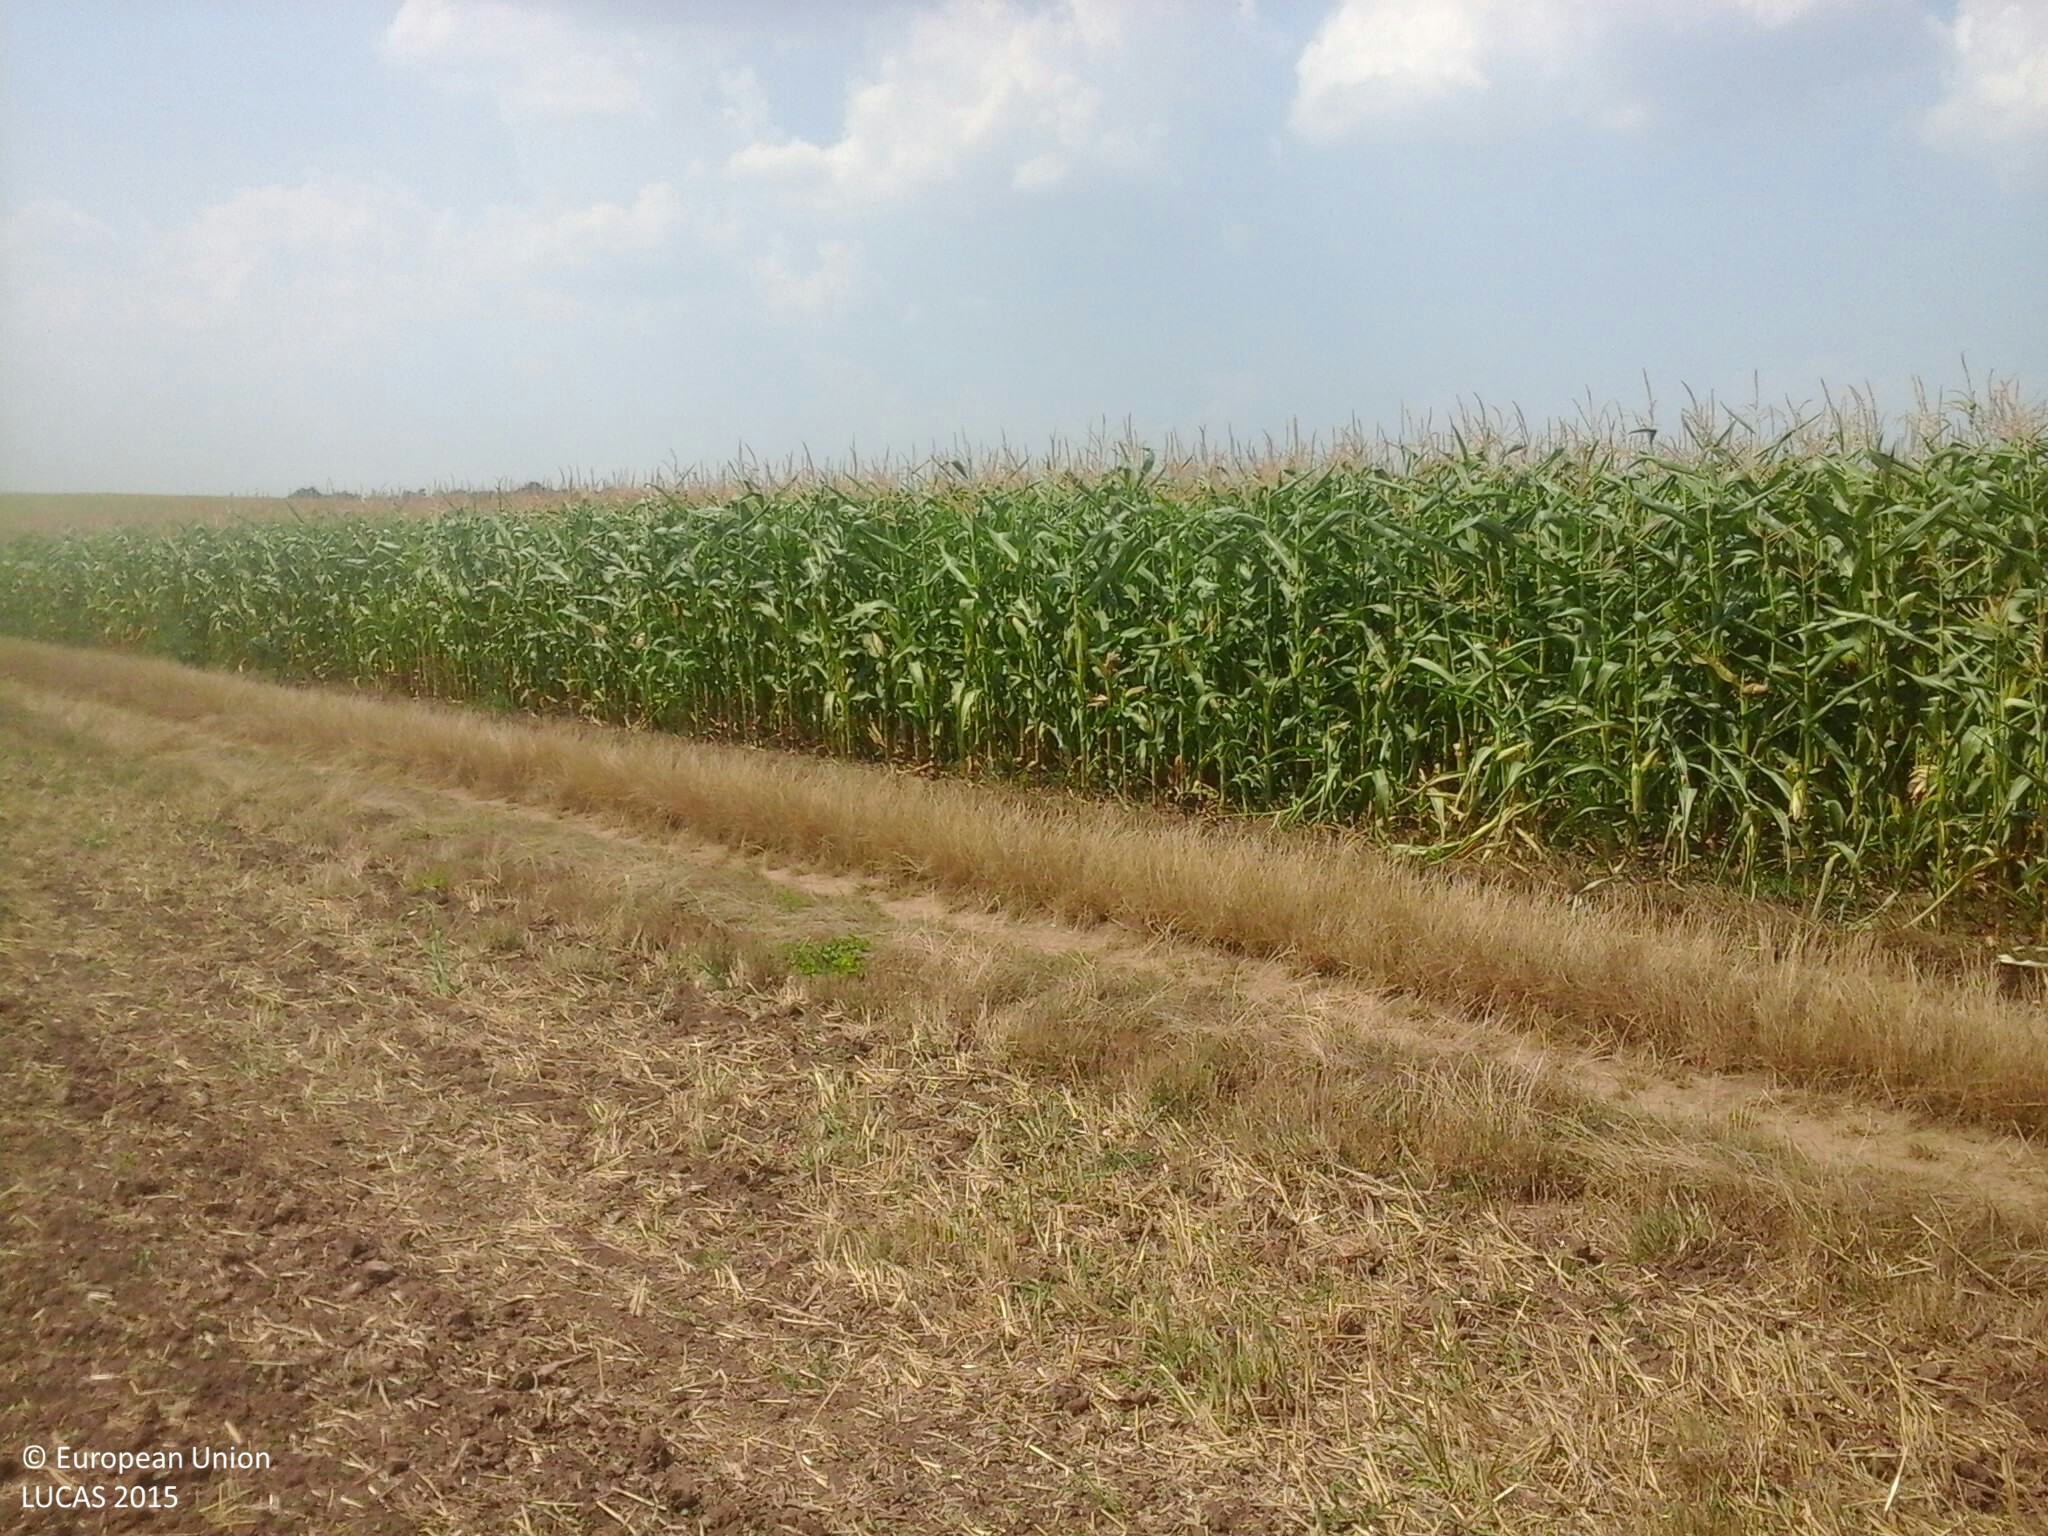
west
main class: Cropland
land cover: Common wheat
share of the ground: < 10 %
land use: Agriculture (excluding fallow land and kitchen gardens)
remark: Harvested field
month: August
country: HU
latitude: 46.8797
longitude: 18.2902
